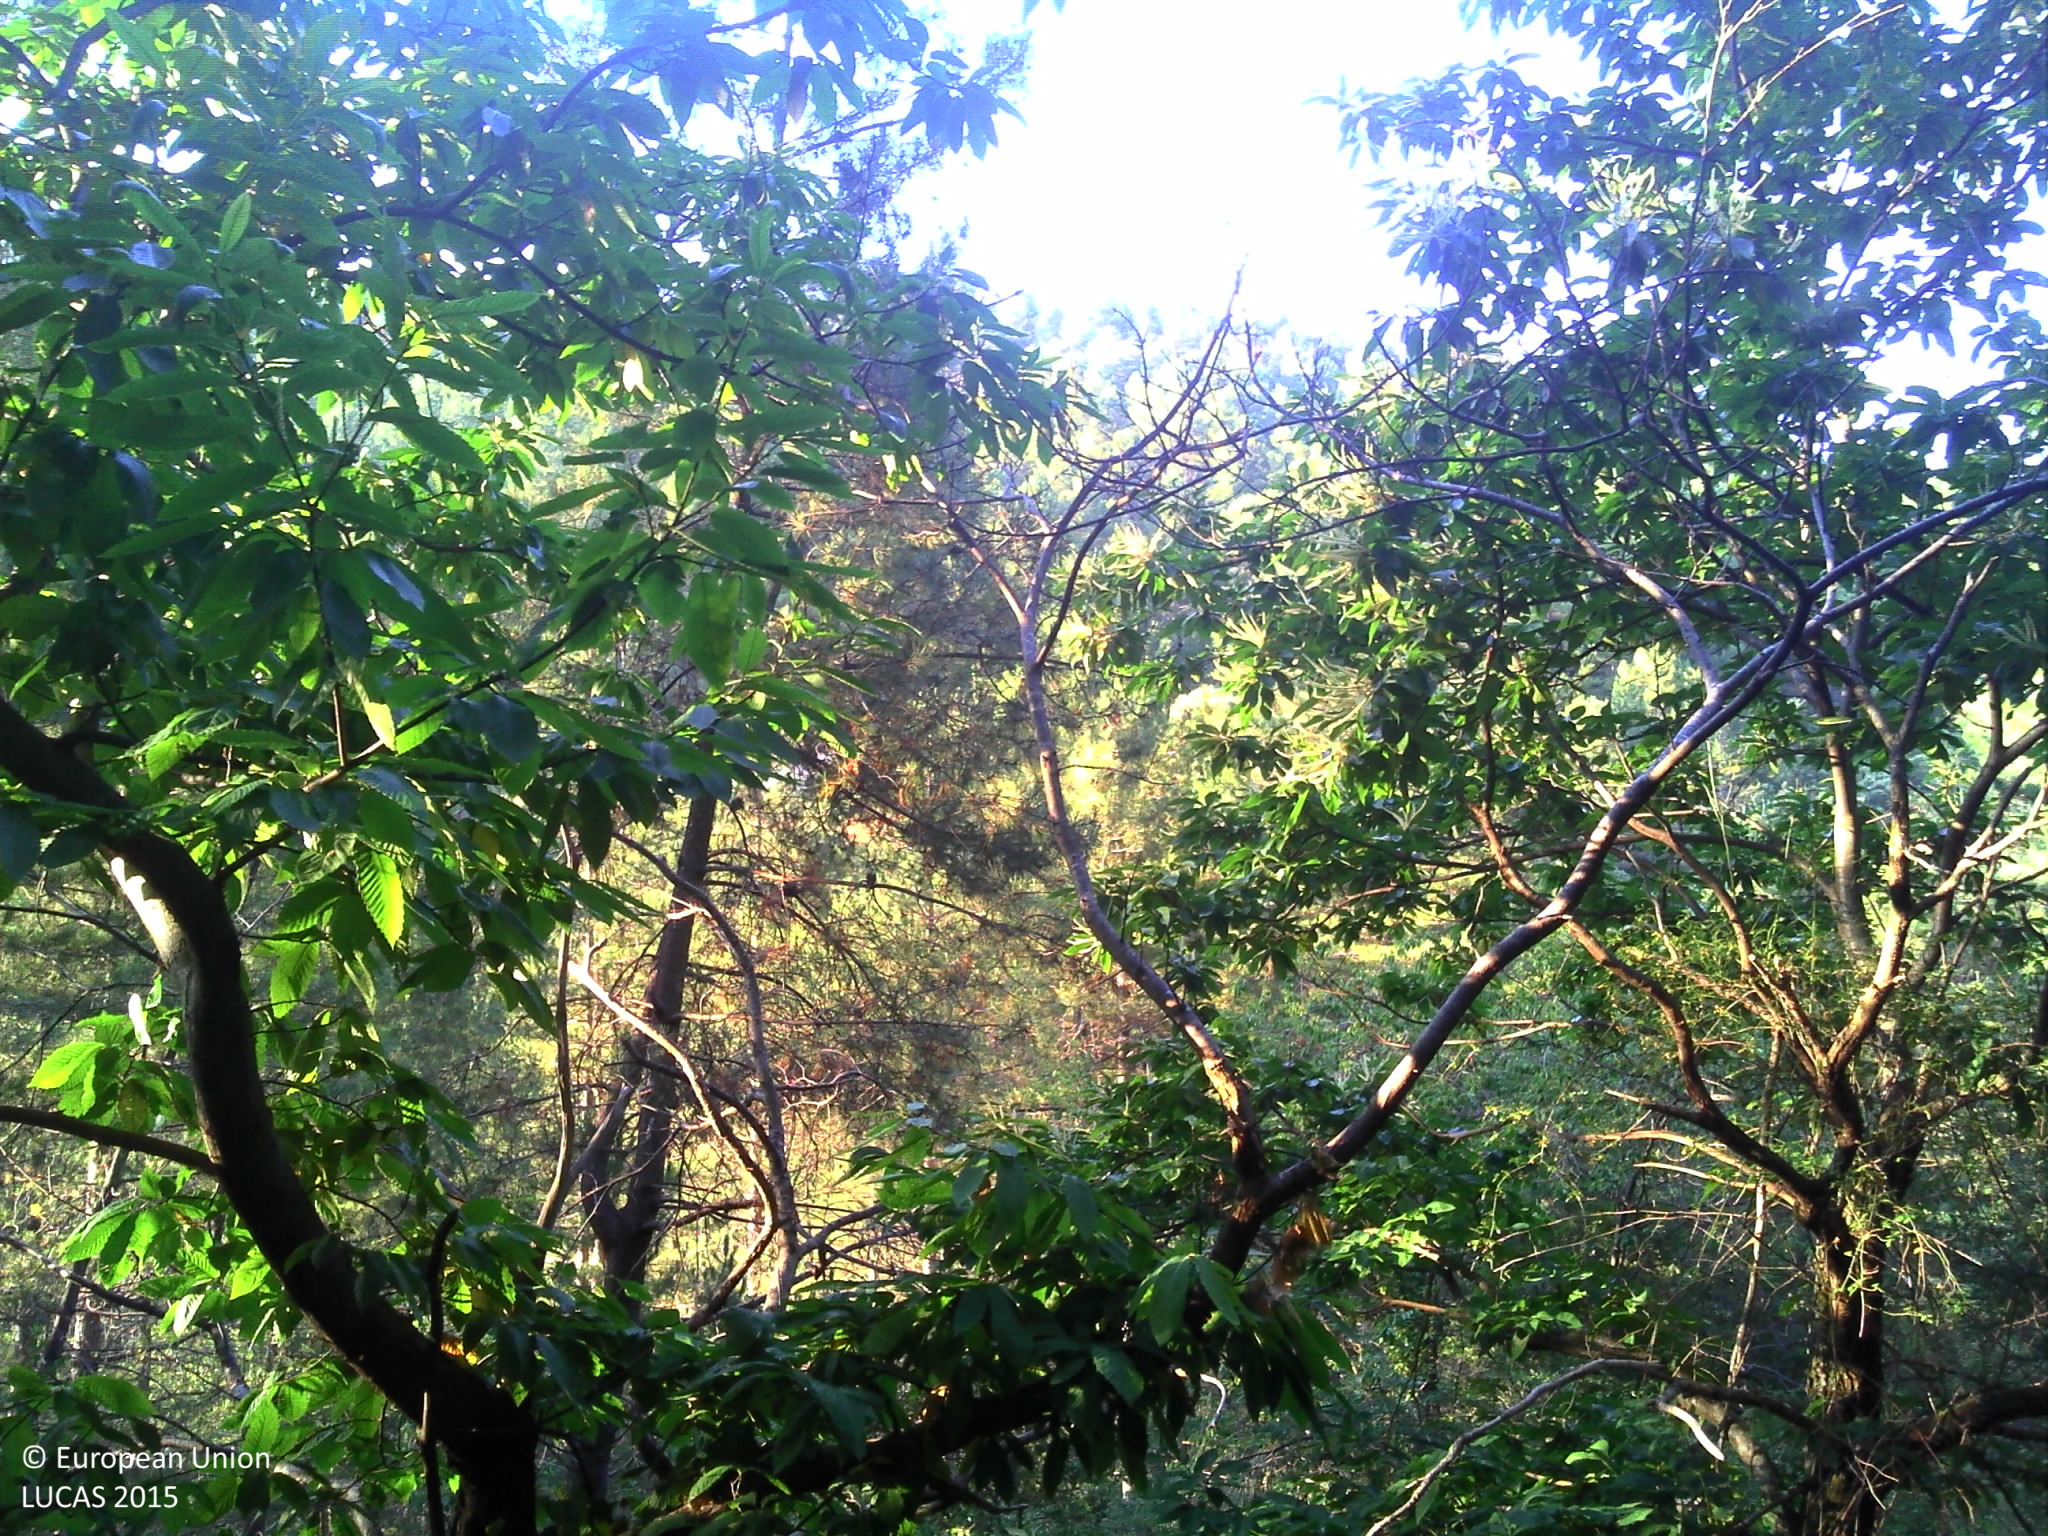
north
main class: Woodland
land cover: Pine dominated mixed woodland
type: coniferous forest of the mediterranean region
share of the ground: > 75 %
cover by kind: broadleaved forest trees 75 %, coniferous forest trees 25 %
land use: Forestry
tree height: > 5 m
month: June
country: FR
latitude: 44.2633
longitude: 3.9315
